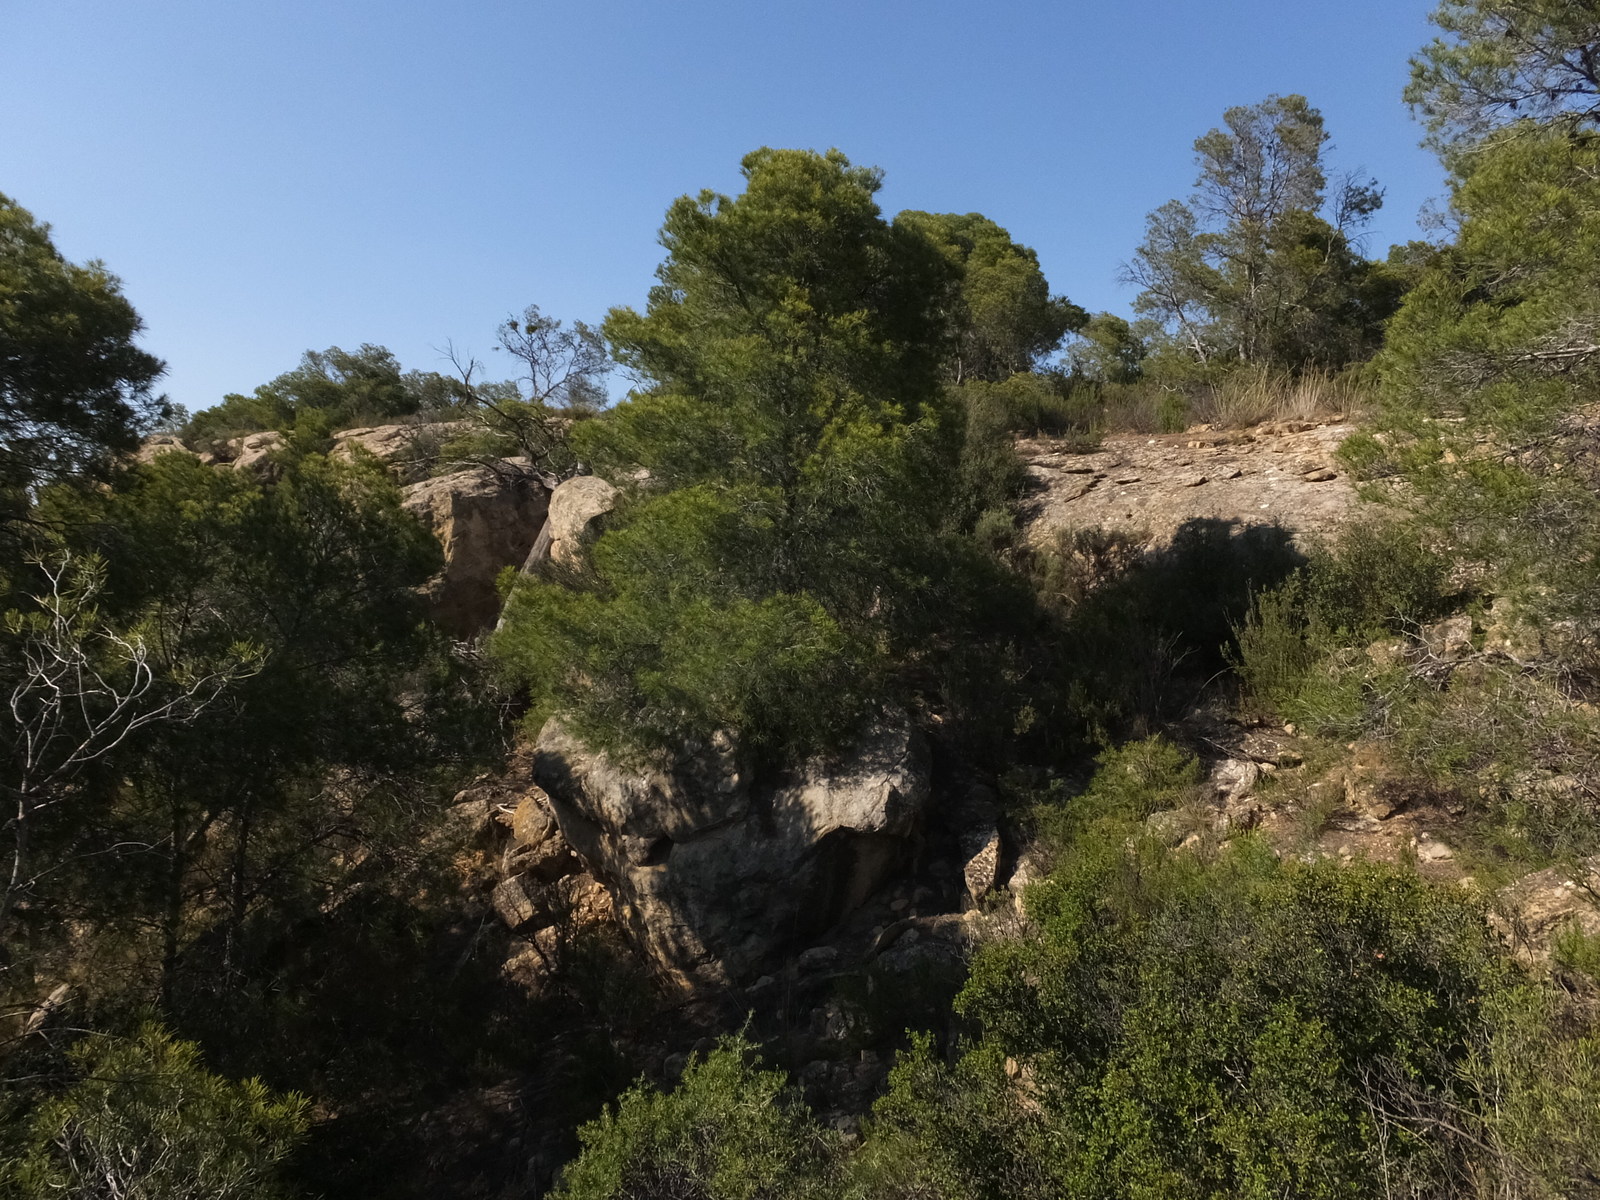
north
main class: Woodland
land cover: Pine dominated mixed woodland
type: coniferous forest of the mediterranean region
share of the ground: 50 - 75 %
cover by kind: coniferous forest trees 60 %, broadleaved forest trees 20 %, shrubs 10 %, herbaceous plants 10 %
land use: Forestry
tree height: > 5 m
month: June
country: ES
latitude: 41.1884
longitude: -0.2308
